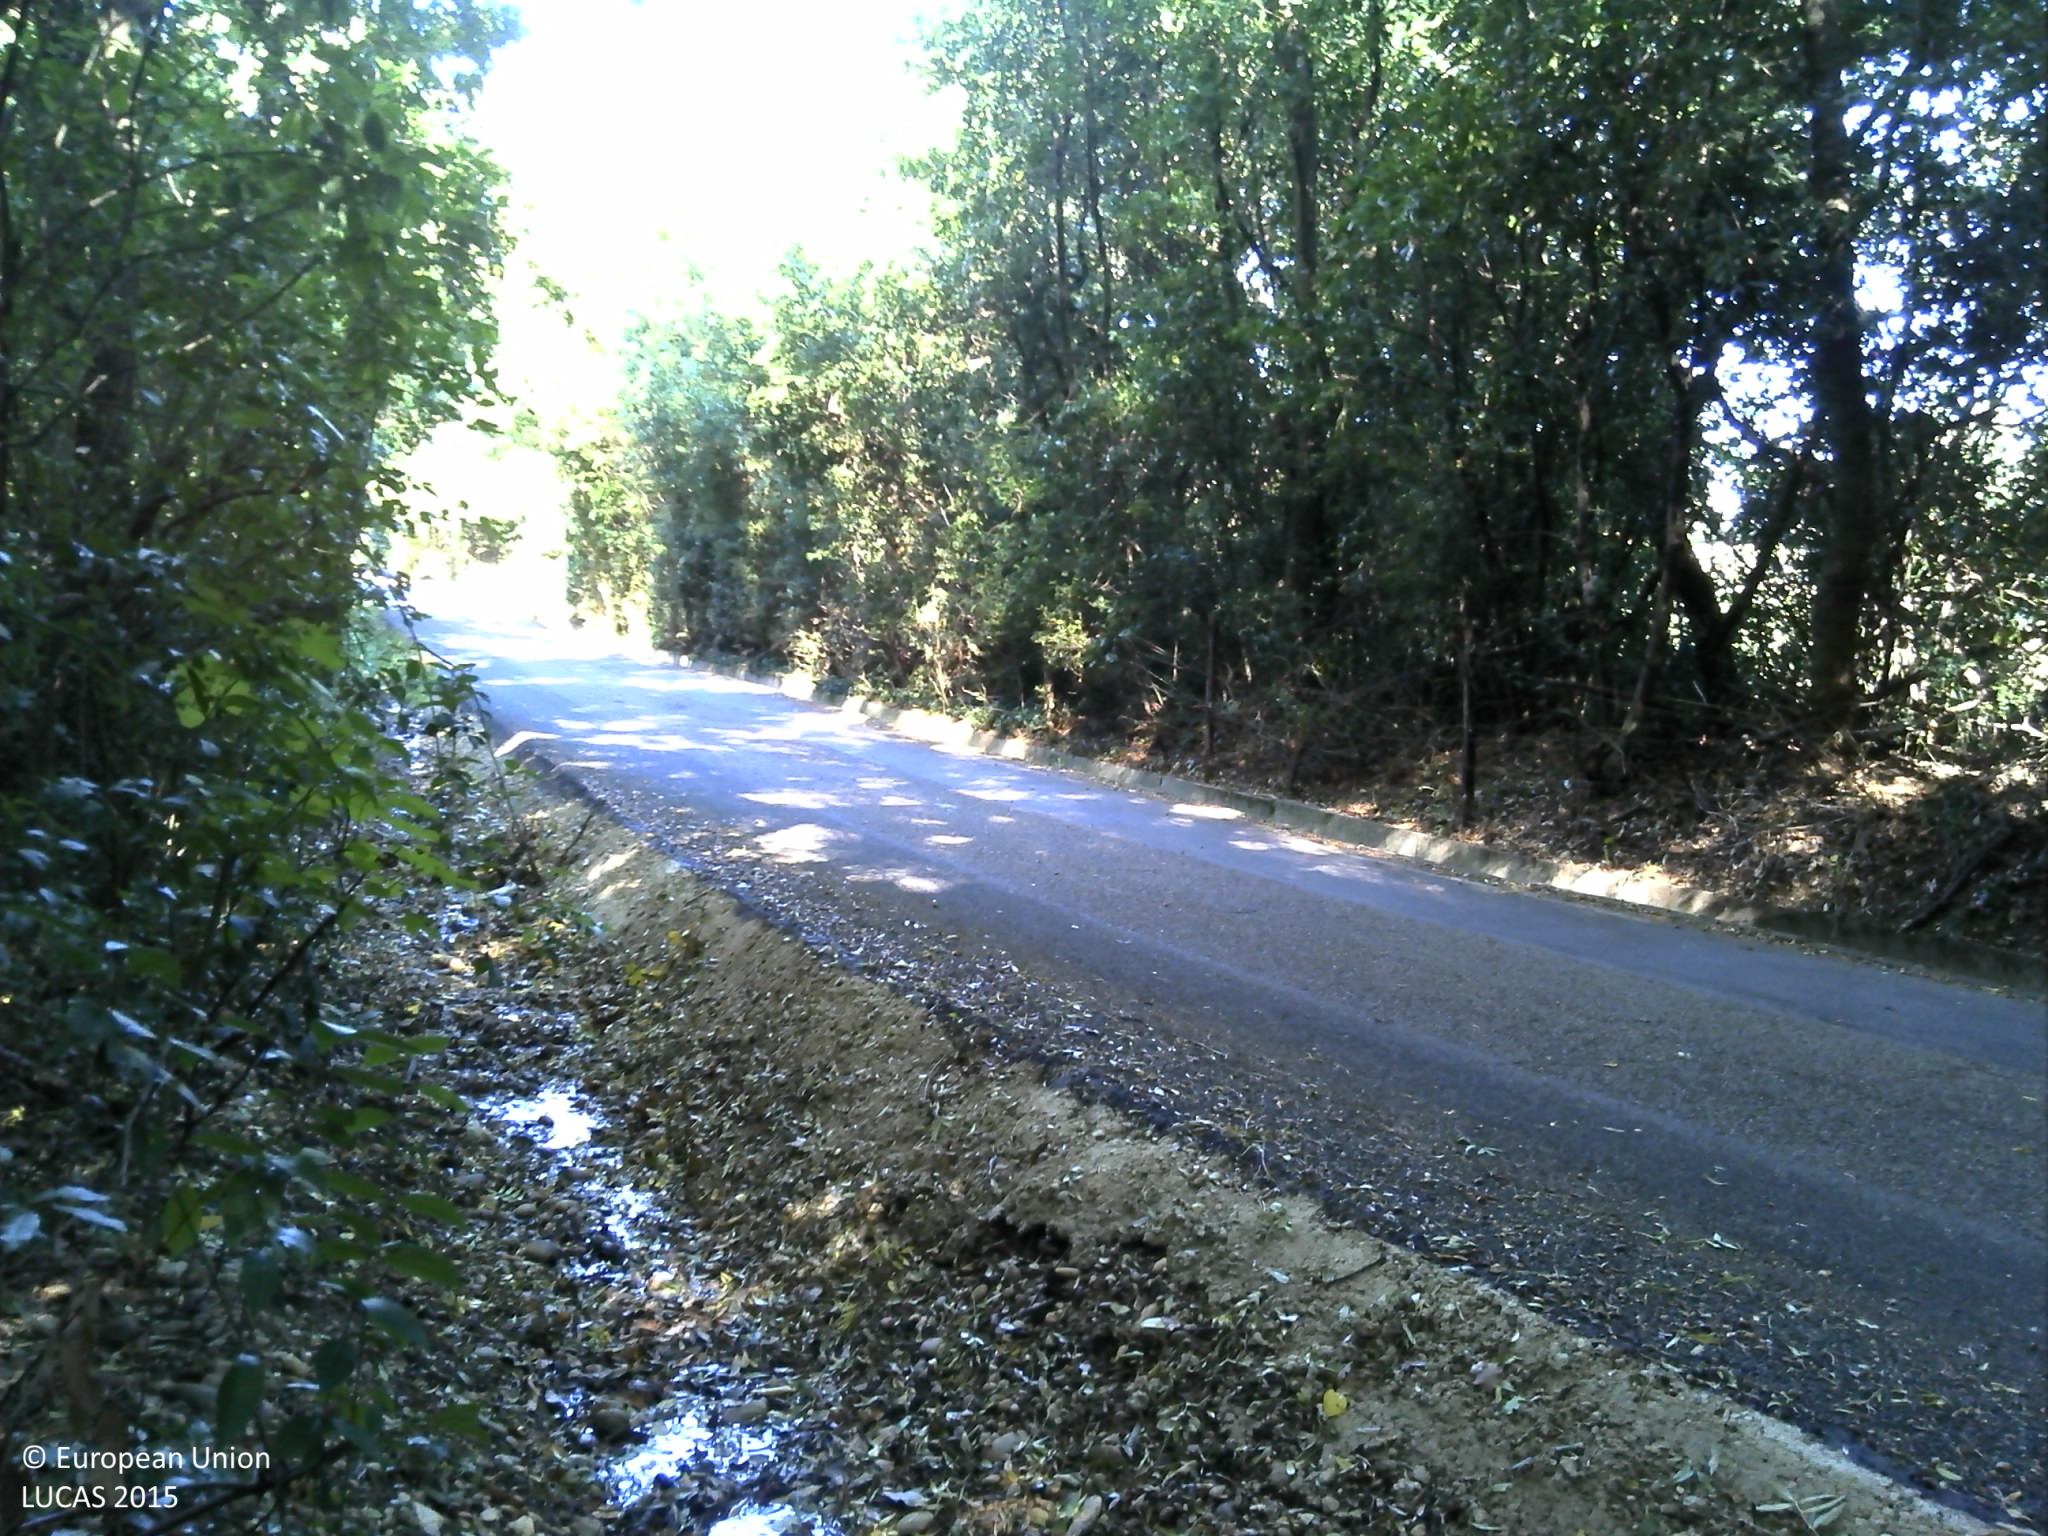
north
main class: Woodland
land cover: Broadleaved woodland
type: broadleaved evergreen forest
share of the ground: > 75 %
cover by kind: broadleaved forest trees 80 %, herbaceous plants 10 %, unconsolidated bare surface 10 %
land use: Semi-natural and natural areas not in use
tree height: > 5 m
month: October
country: FR
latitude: 43.7644
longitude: 4.3819
